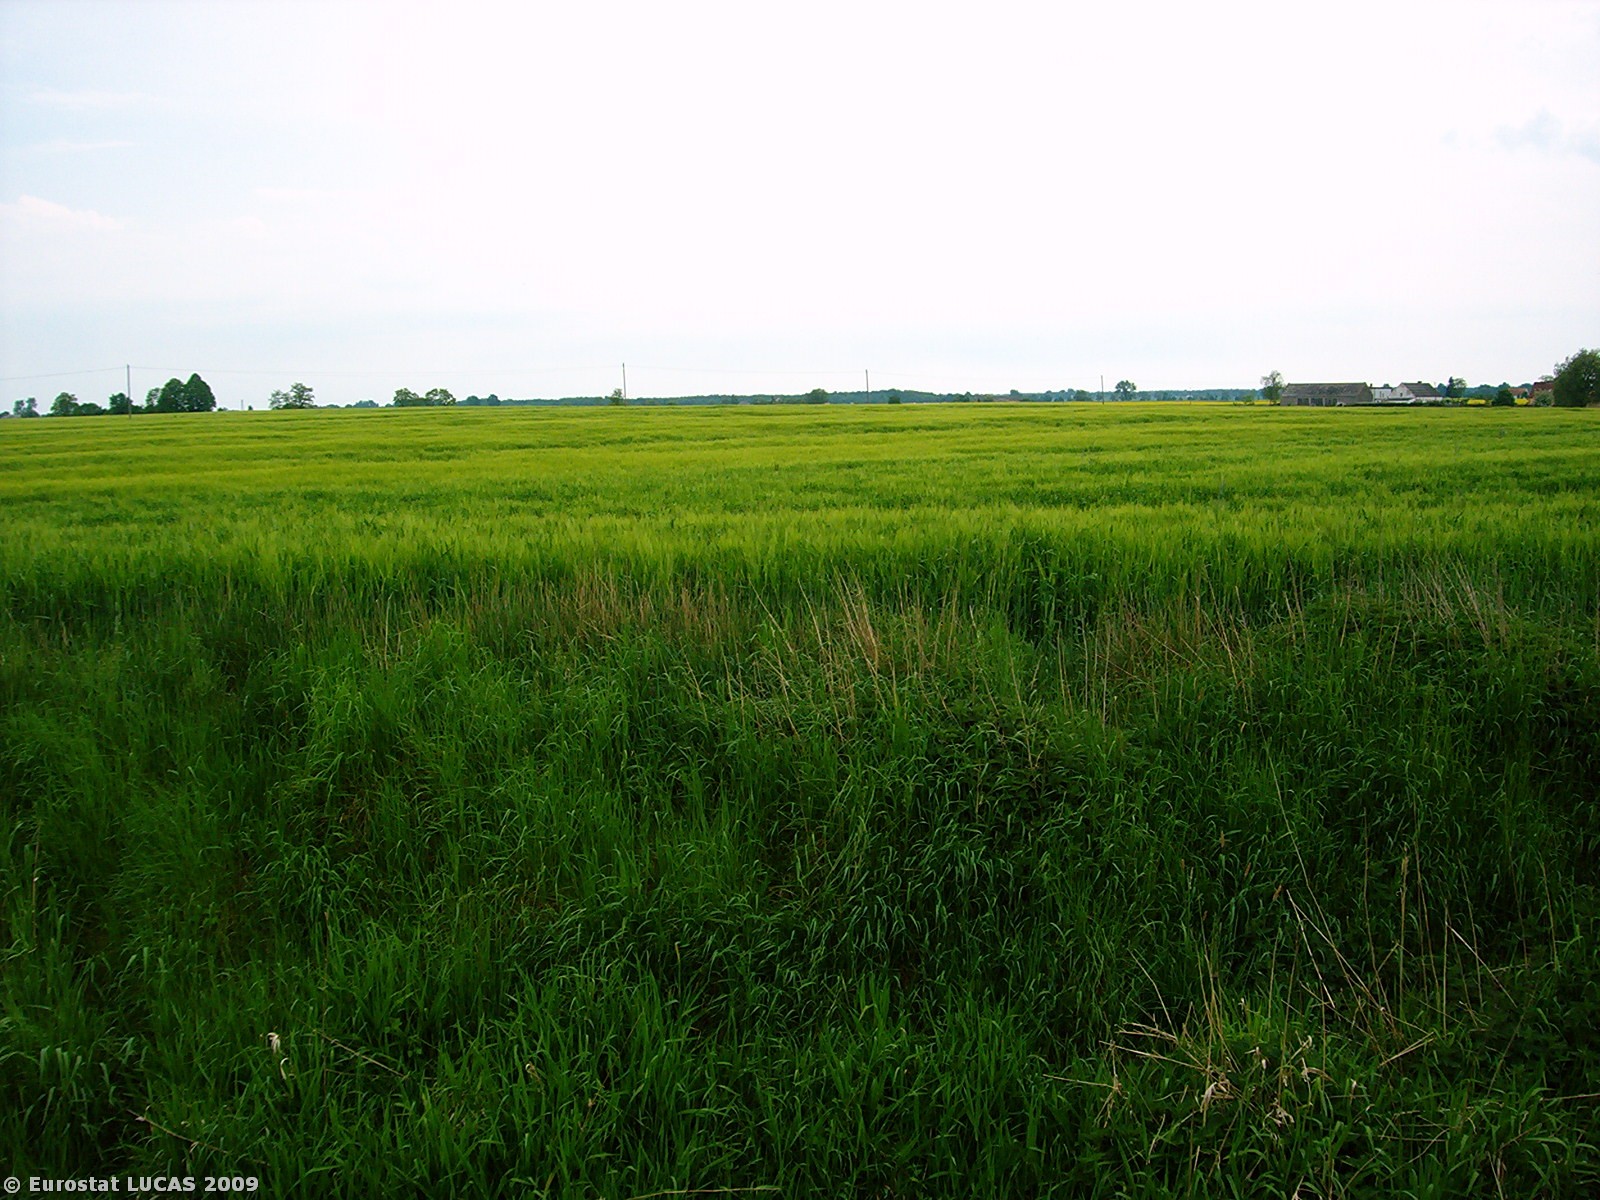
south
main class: Cropland
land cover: Rape and turnip rape
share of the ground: > 75 %
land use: Agriculture (excluding fallow land and kitchen gardens)
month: May
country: PL
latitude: 52.6520
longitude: 16.4669
